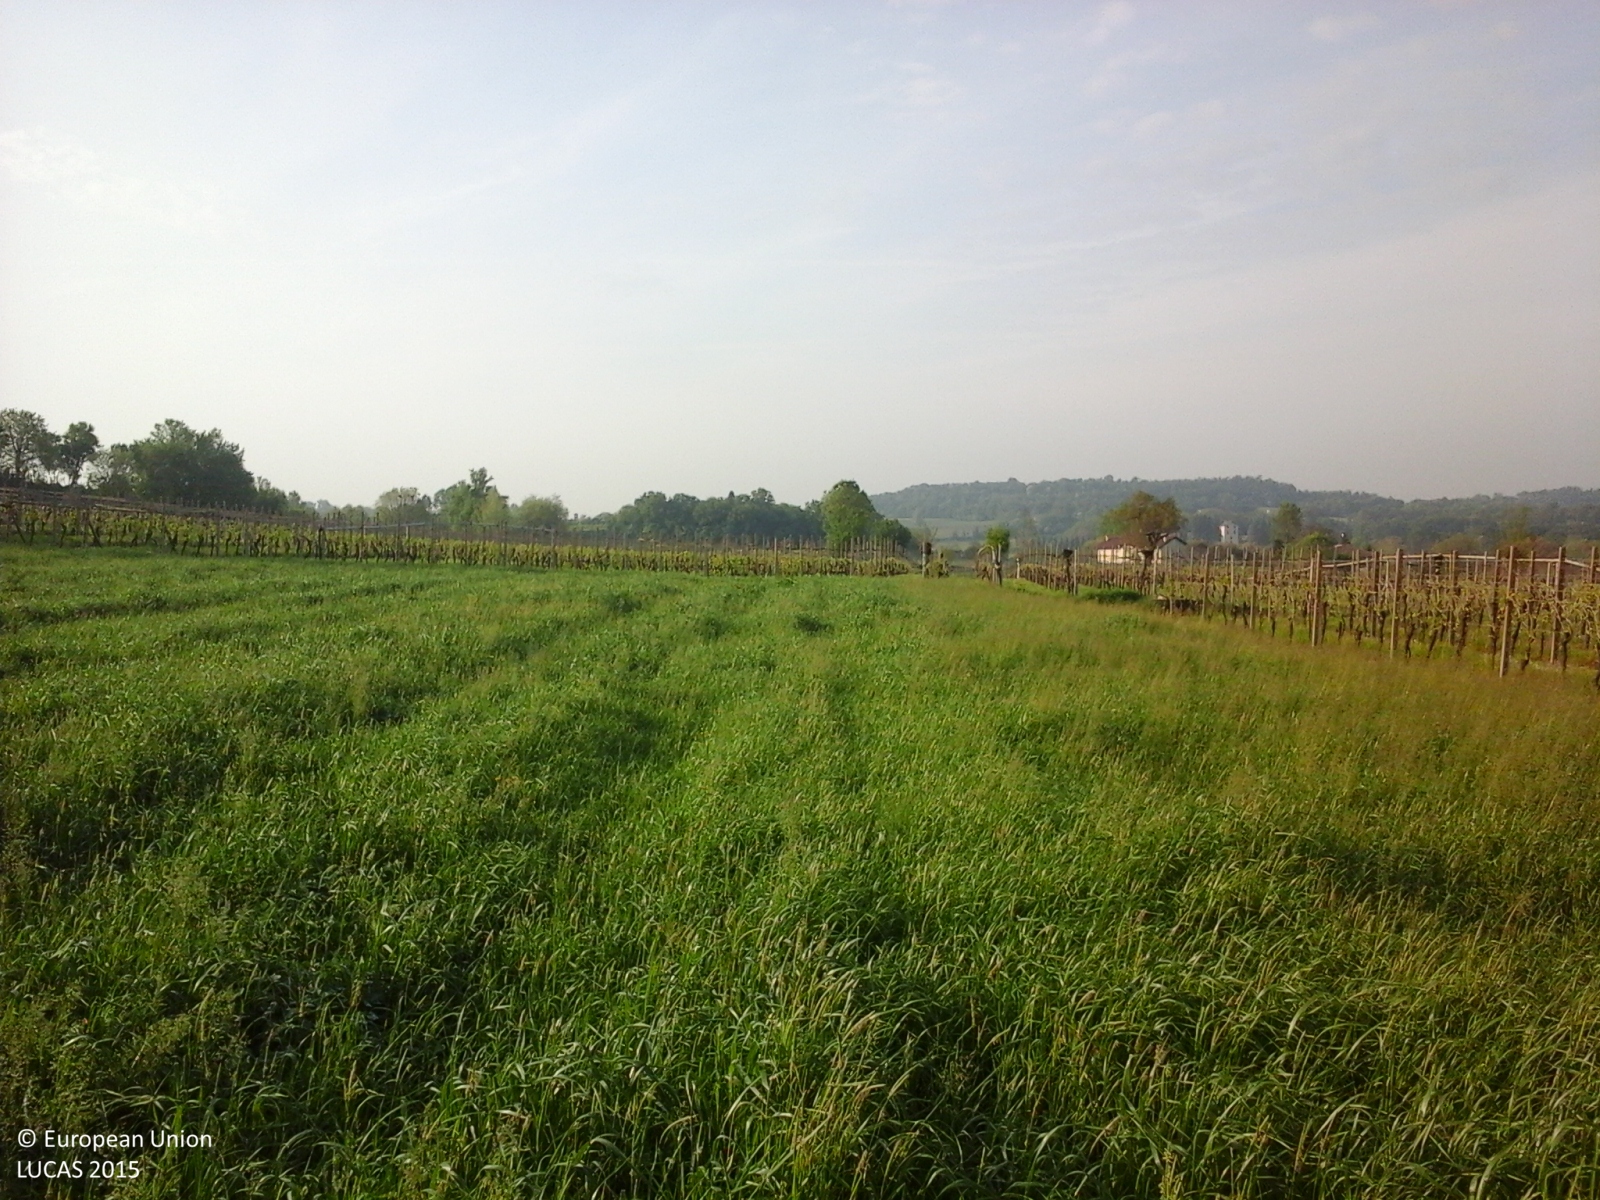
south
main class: Cropland
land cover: Other leguminous and mixtures for fodder
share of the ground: > 75 %
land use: Agriculture (excluding fallow land and kitchen gardens)
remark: Tilled/Sowed
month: April
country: IT
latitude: 45.3938
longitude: 10.7268
